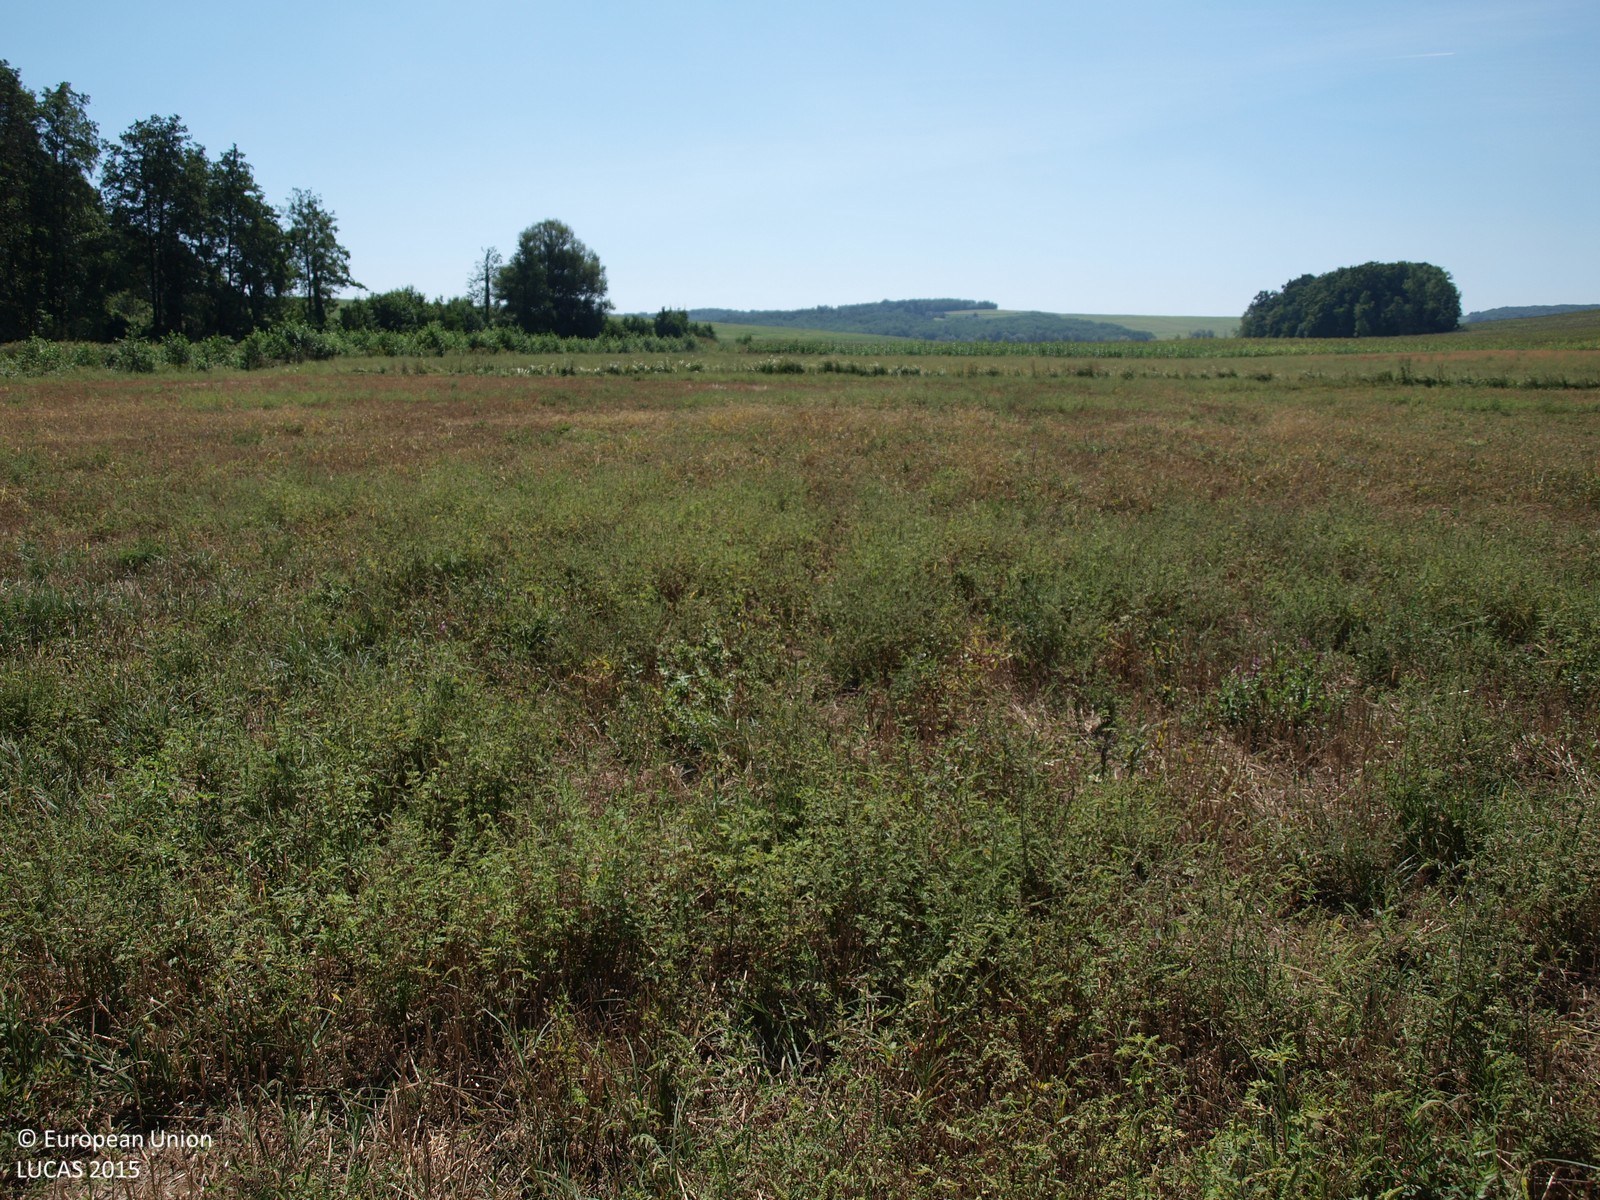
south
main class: Cropland
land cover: Barley
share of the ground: > 75 %
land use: Agriculture (excluding fallow land and kitchen gardens)
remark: Harvested field
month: August
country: HR
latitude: 46.0518
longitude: 16.6824
